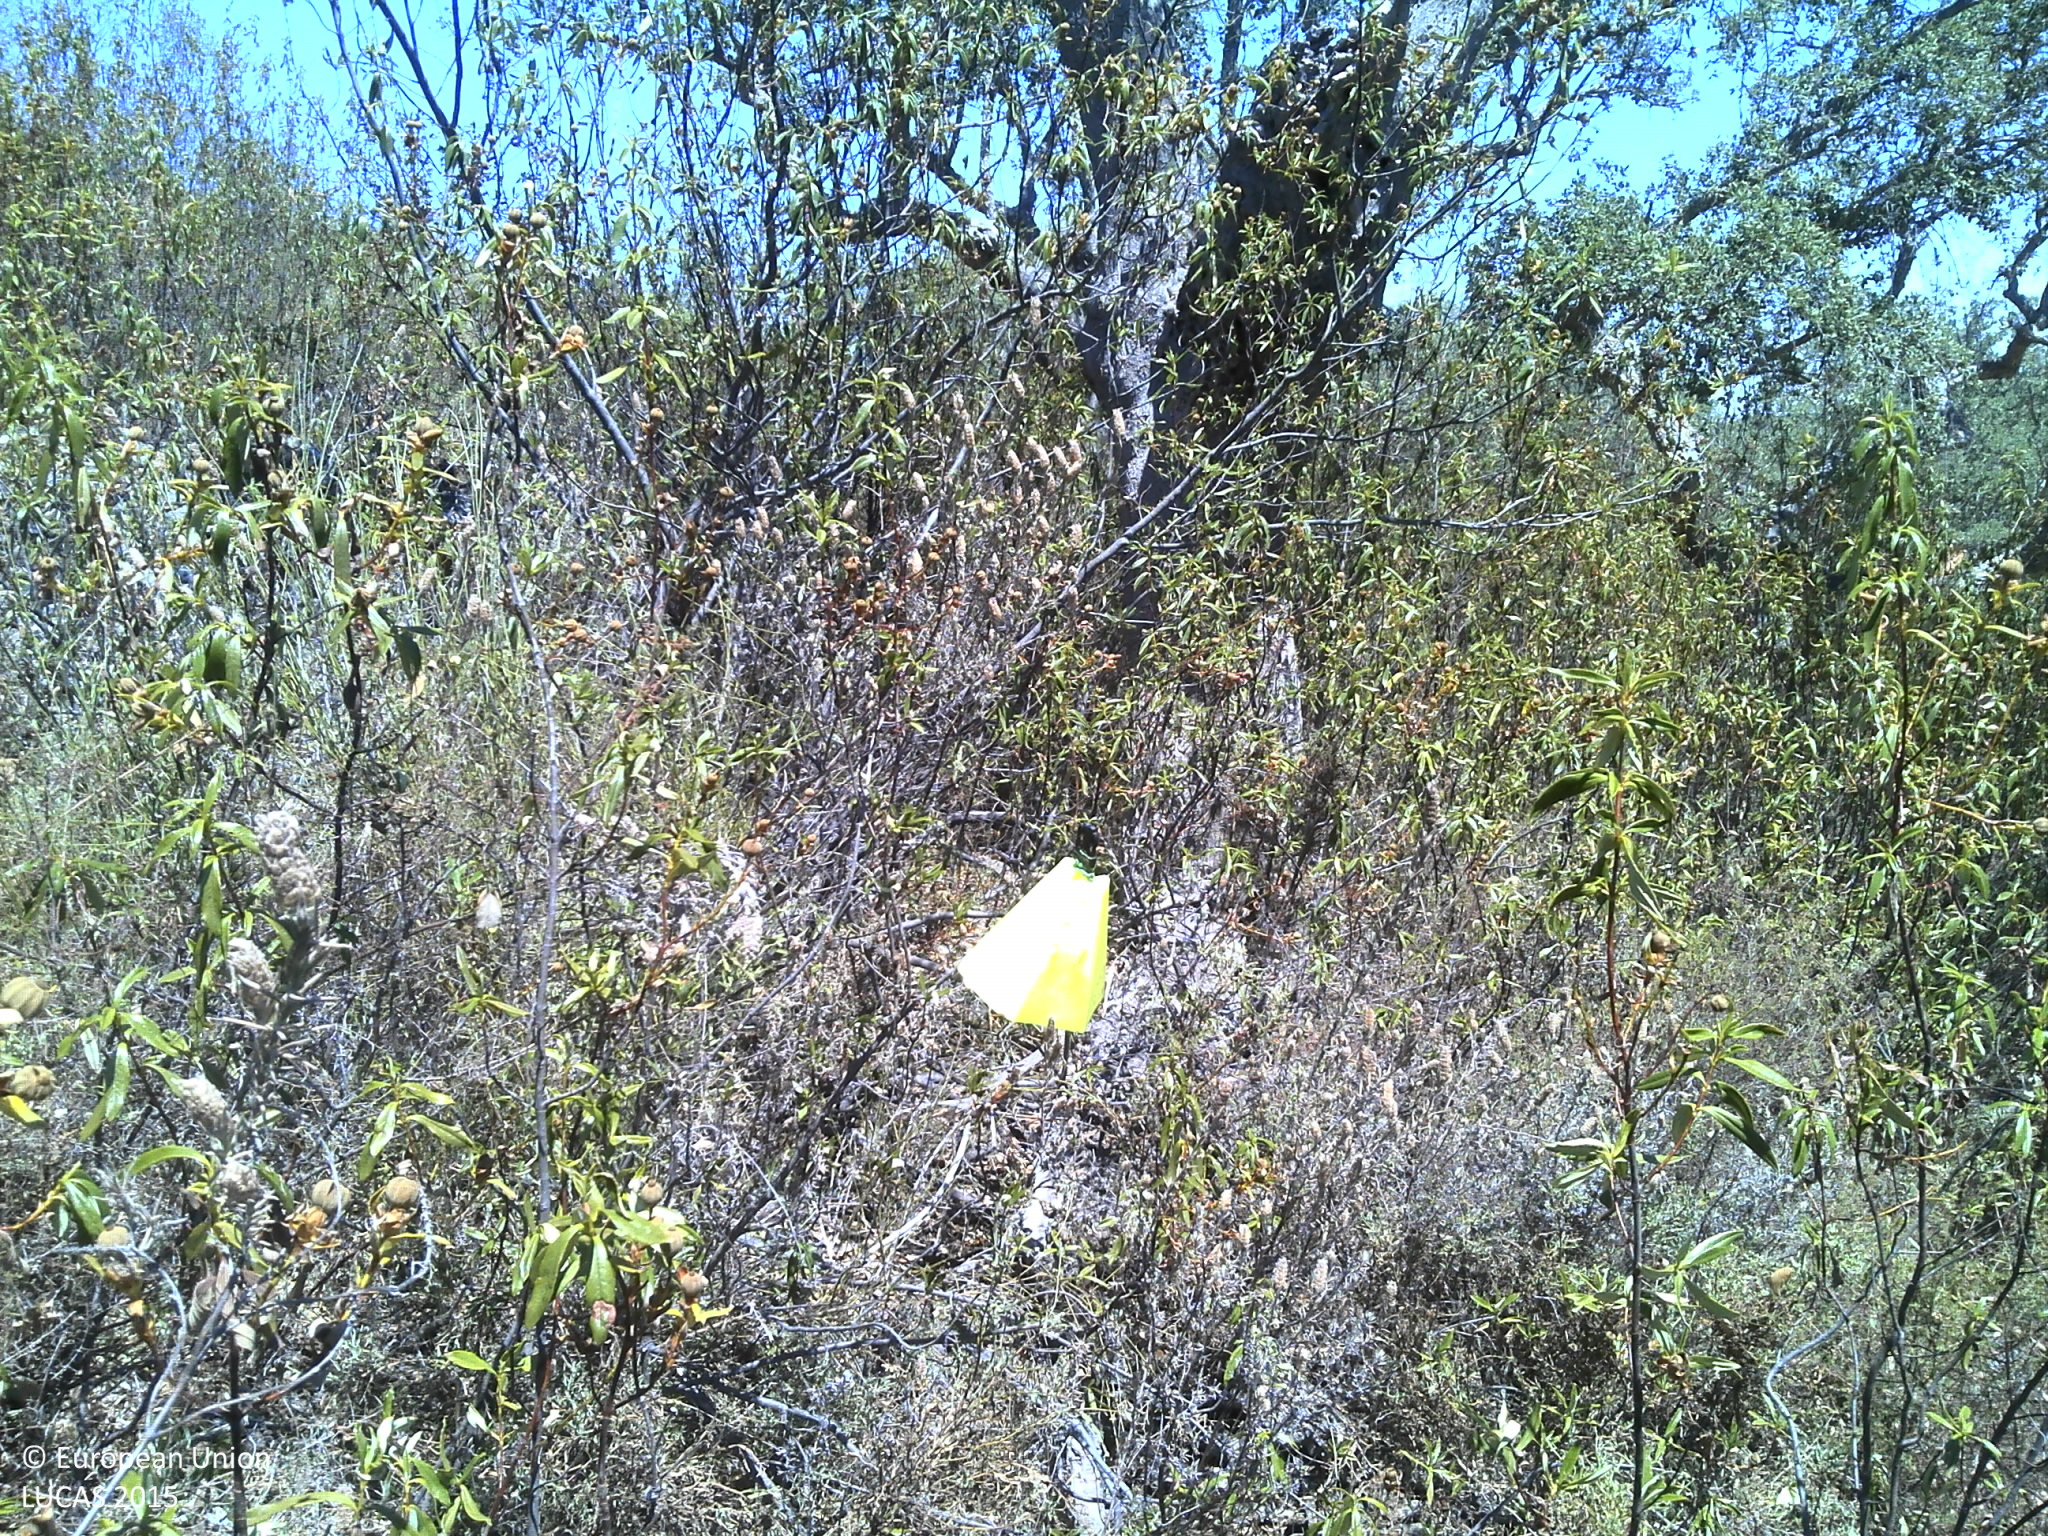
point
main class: Woodland
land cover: Broadleaved woodland
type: broadleaved evergreen forest
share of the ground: 25 - 50 %
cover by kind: shrubs 75 %, broadleaved forest trees 25 %
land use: Forestry
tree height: > 5 m
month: July
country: PT
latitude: 39.1469
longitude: -7.1690
